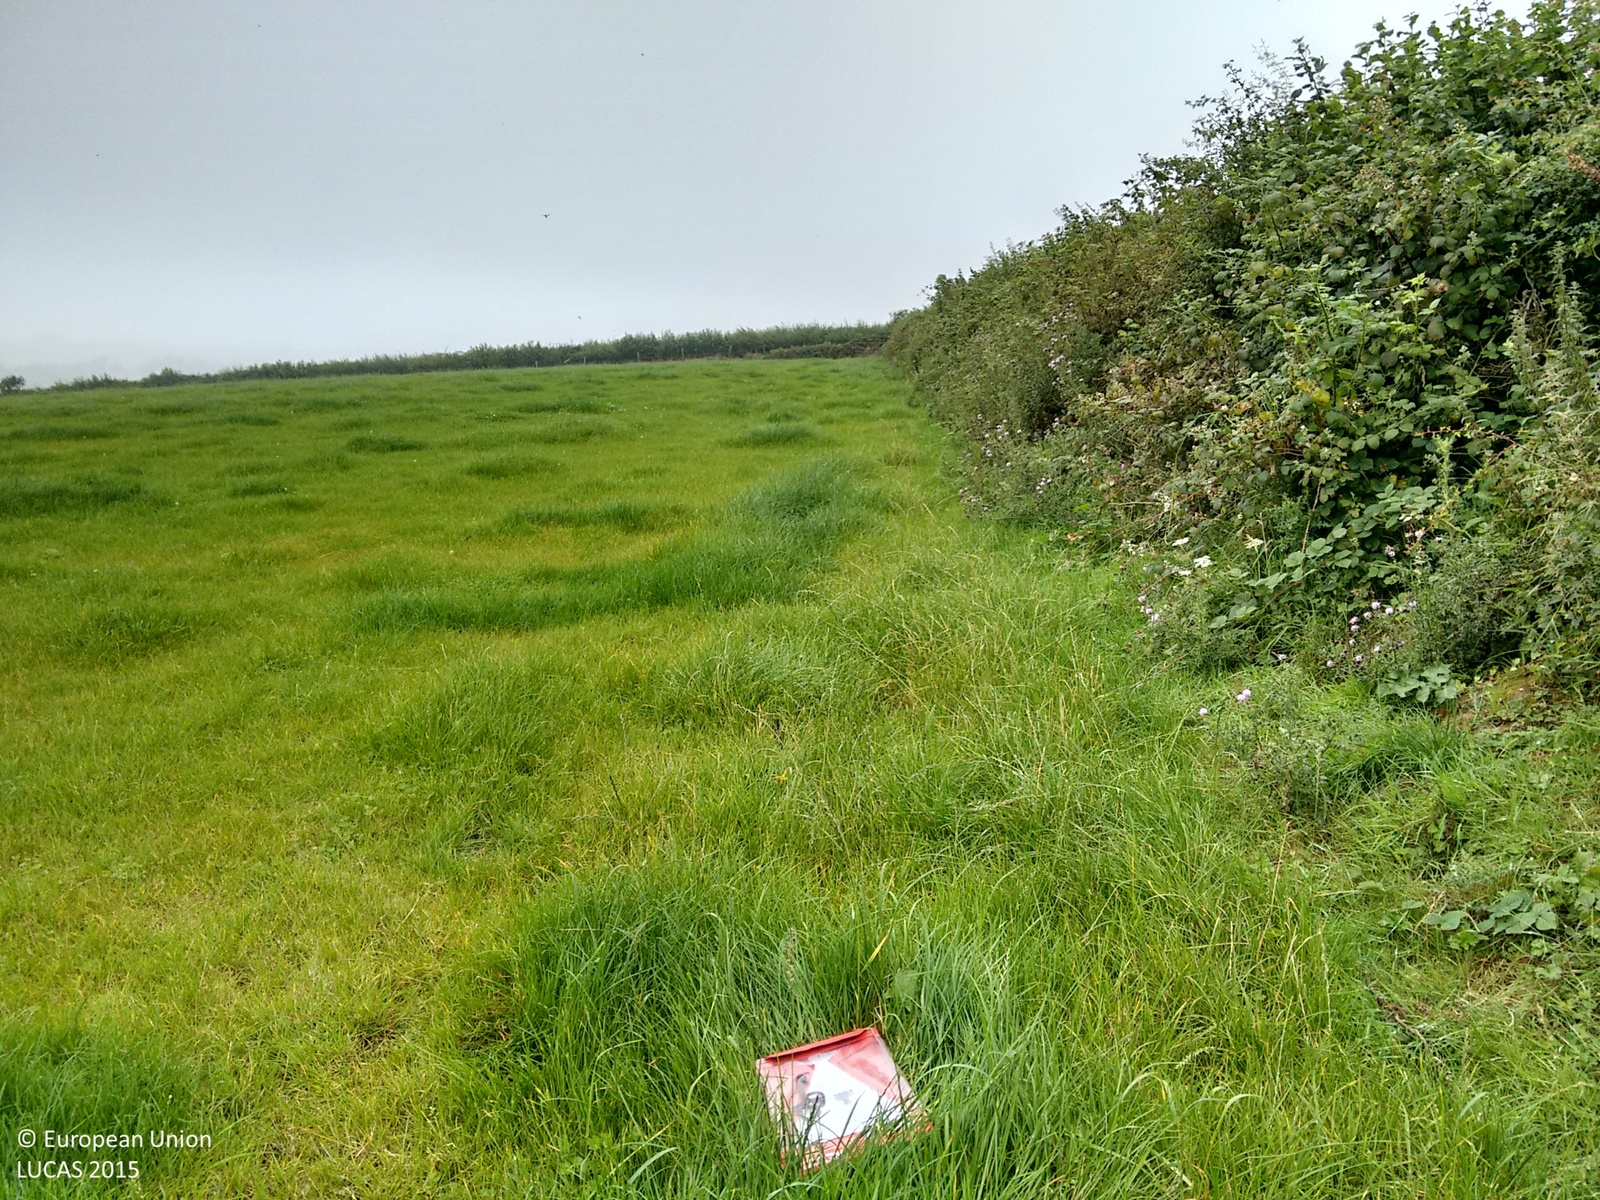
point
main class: Grassland
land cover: Grassland without tree/shrub cover
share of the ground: > 75 %
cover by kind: herbaceous plants 100 %
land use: Agriculture (excluding fallow land and kitchen gardens)
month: August
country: GB
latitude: 51.7908
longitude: -4.6506
